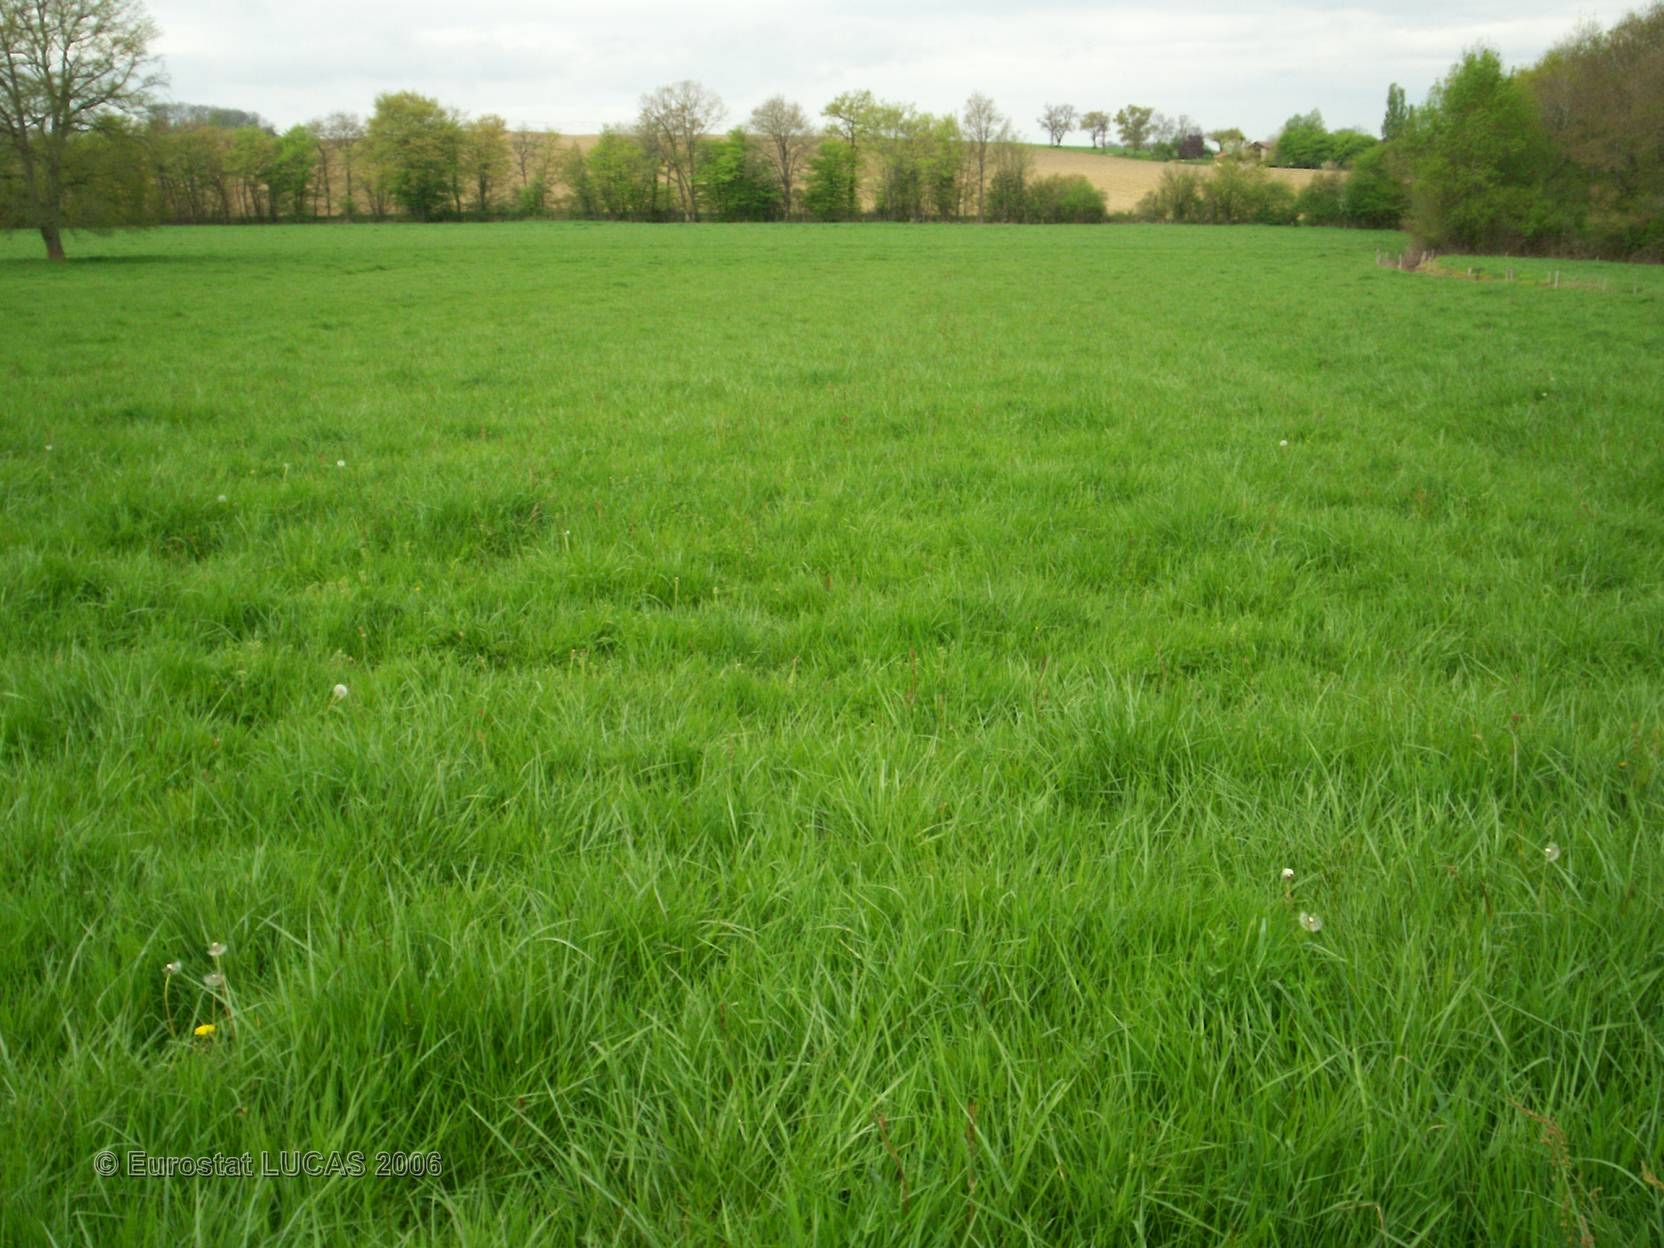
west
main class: Grassland
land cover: Grassland without tree/shrub cover
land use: Agriculture (excluding fallow land and kitchen gardens)
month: April
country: FR
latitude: 43.7223
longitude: 0.2007
